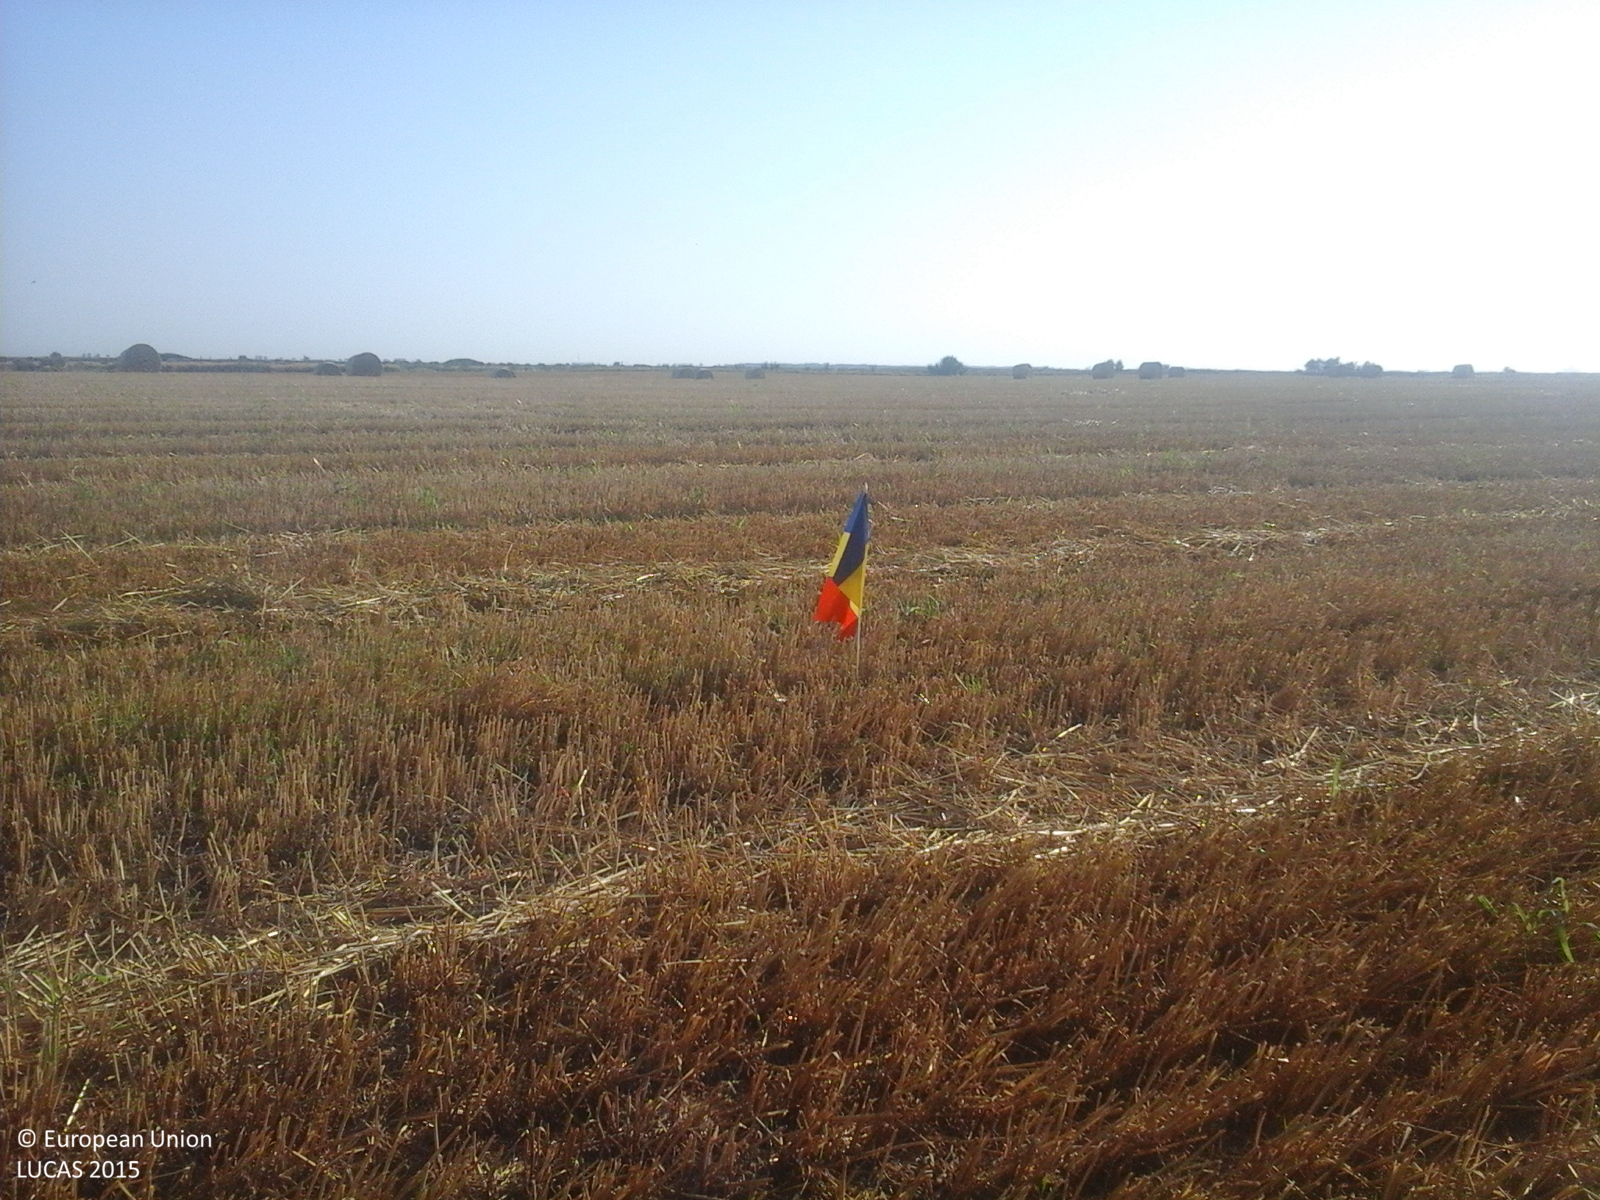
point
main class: Cropland
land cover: Durum wheat
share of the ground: 10 - 25 %
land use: Agriculture (excluding fallow land and kitchen gardens)
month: July
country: RO
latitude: 44.3850
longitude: 27.2431
